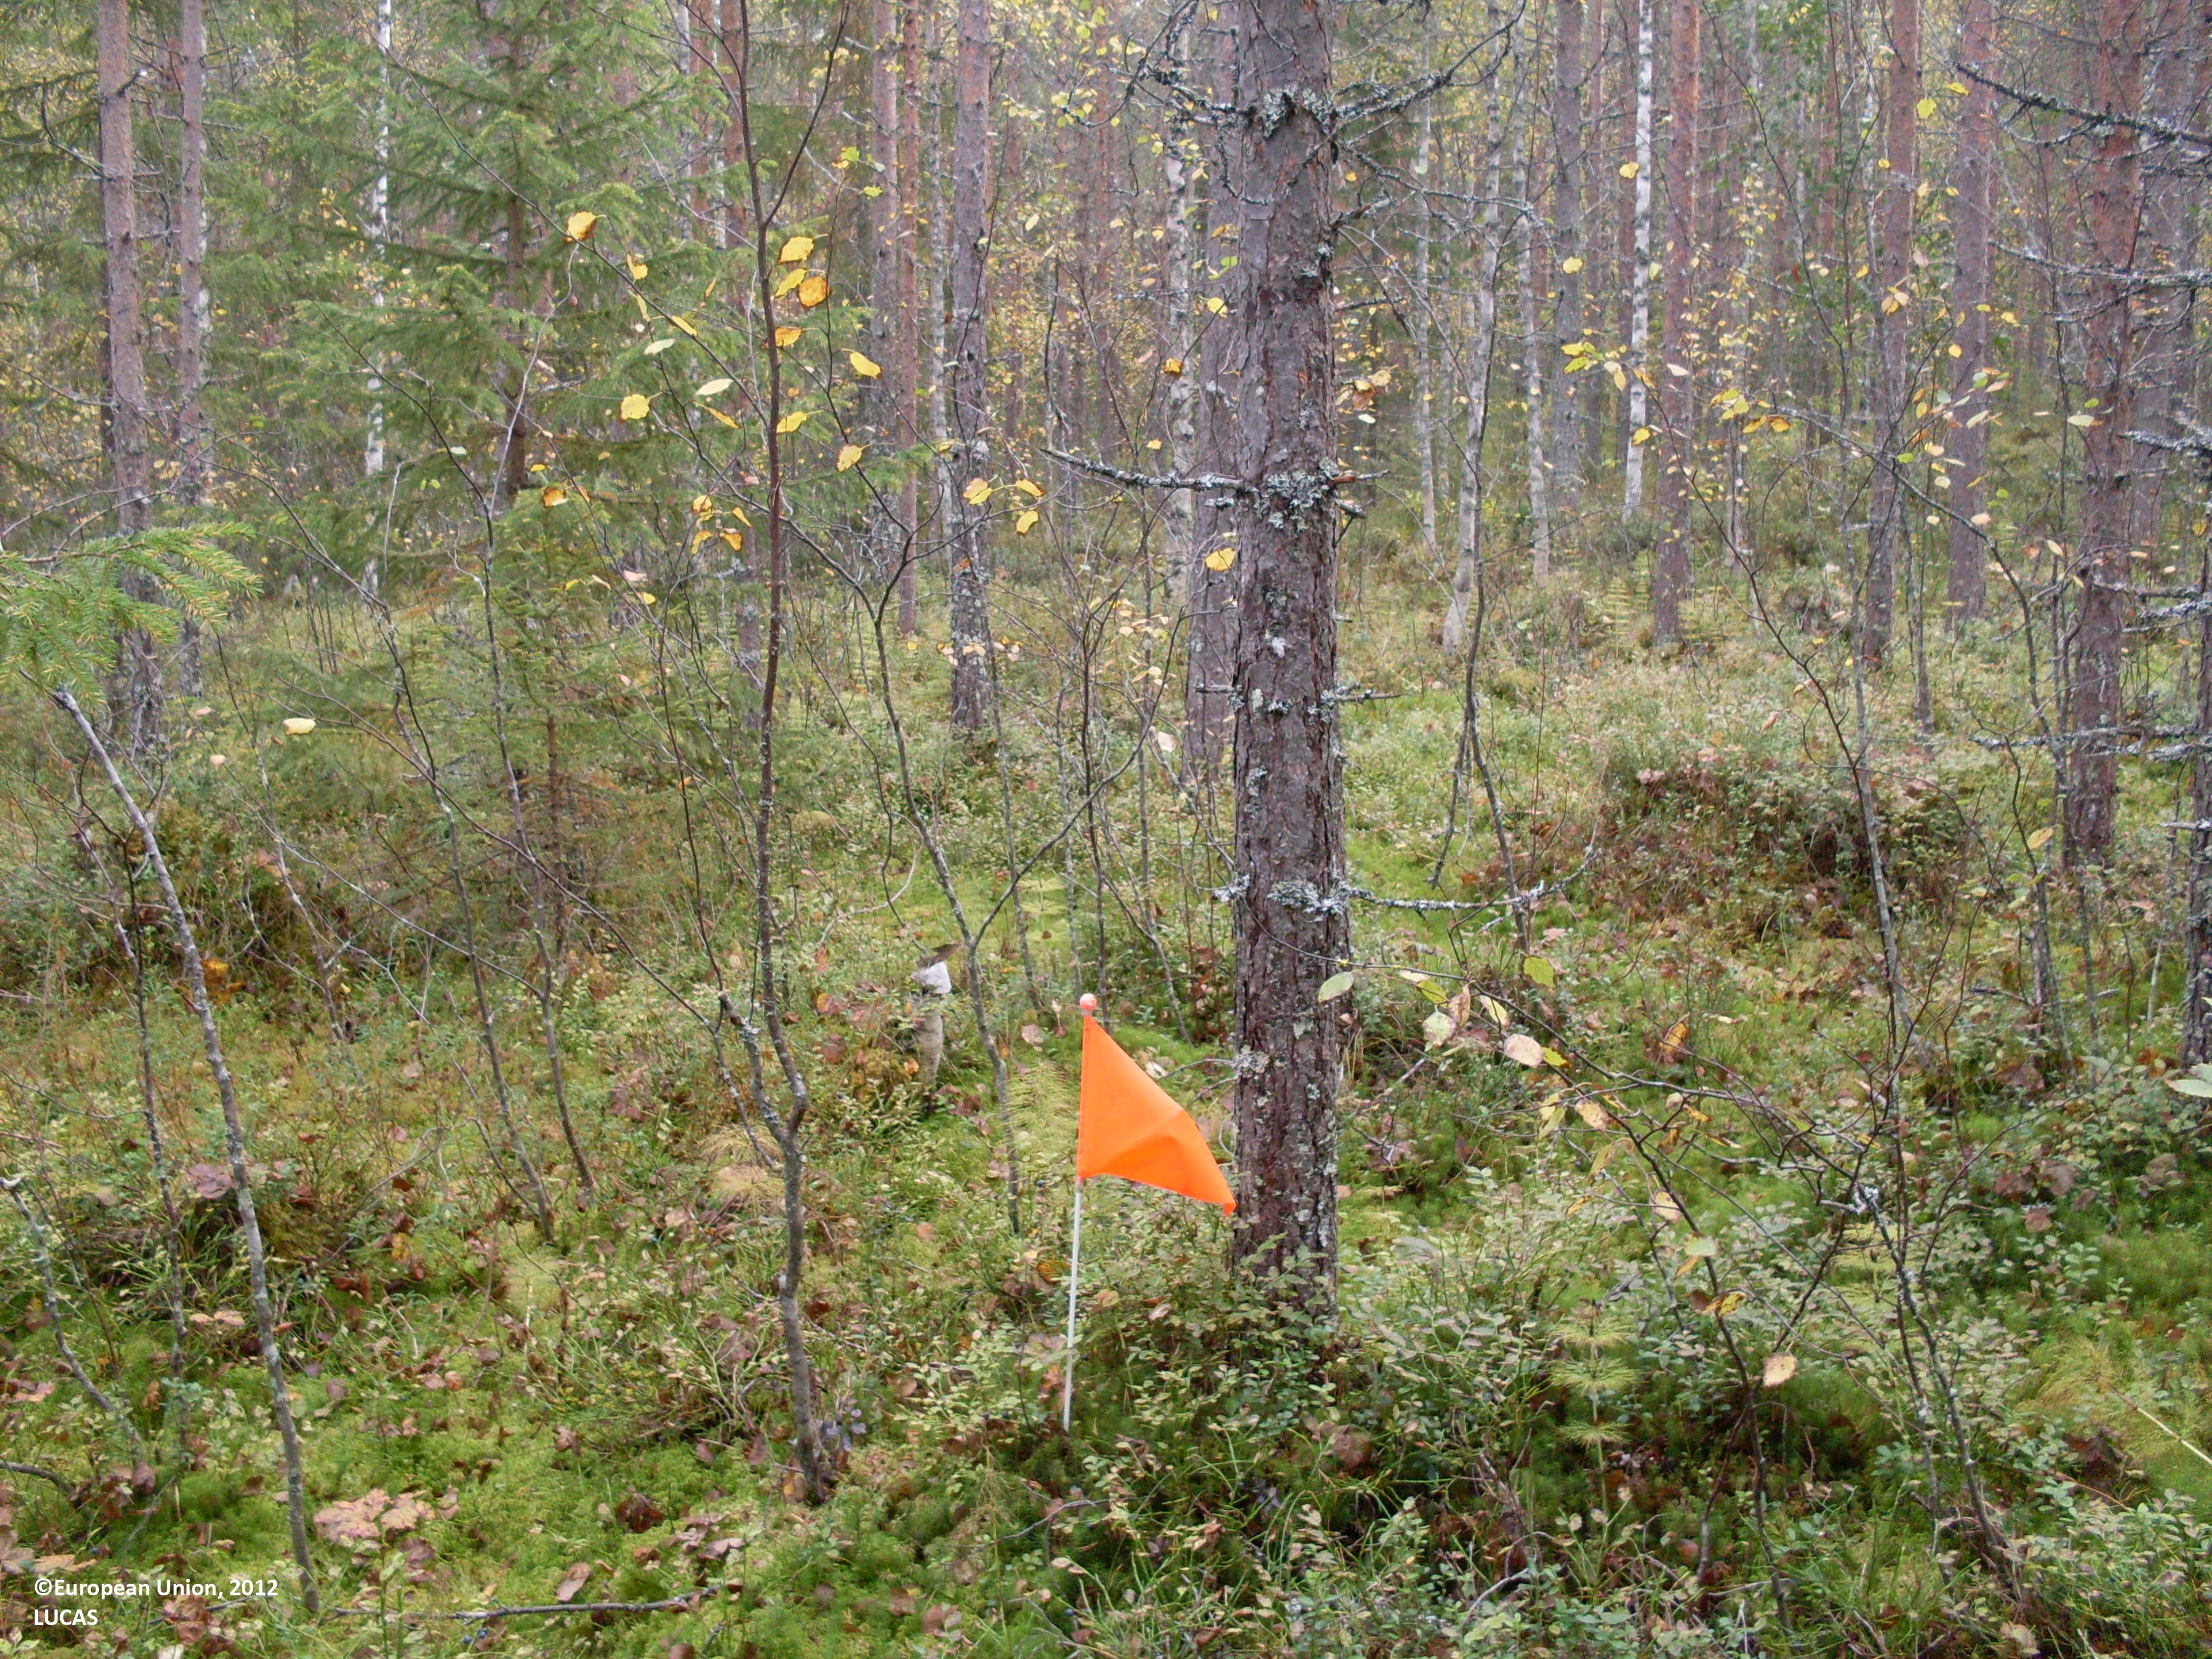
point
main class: Woodland
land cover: Pine dominated coniferous woodland
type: boreal forest
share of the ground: > 75 %
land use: Forestry
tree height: > 5 m
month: September
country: FI
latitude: 64.2655
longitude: 30.2931
